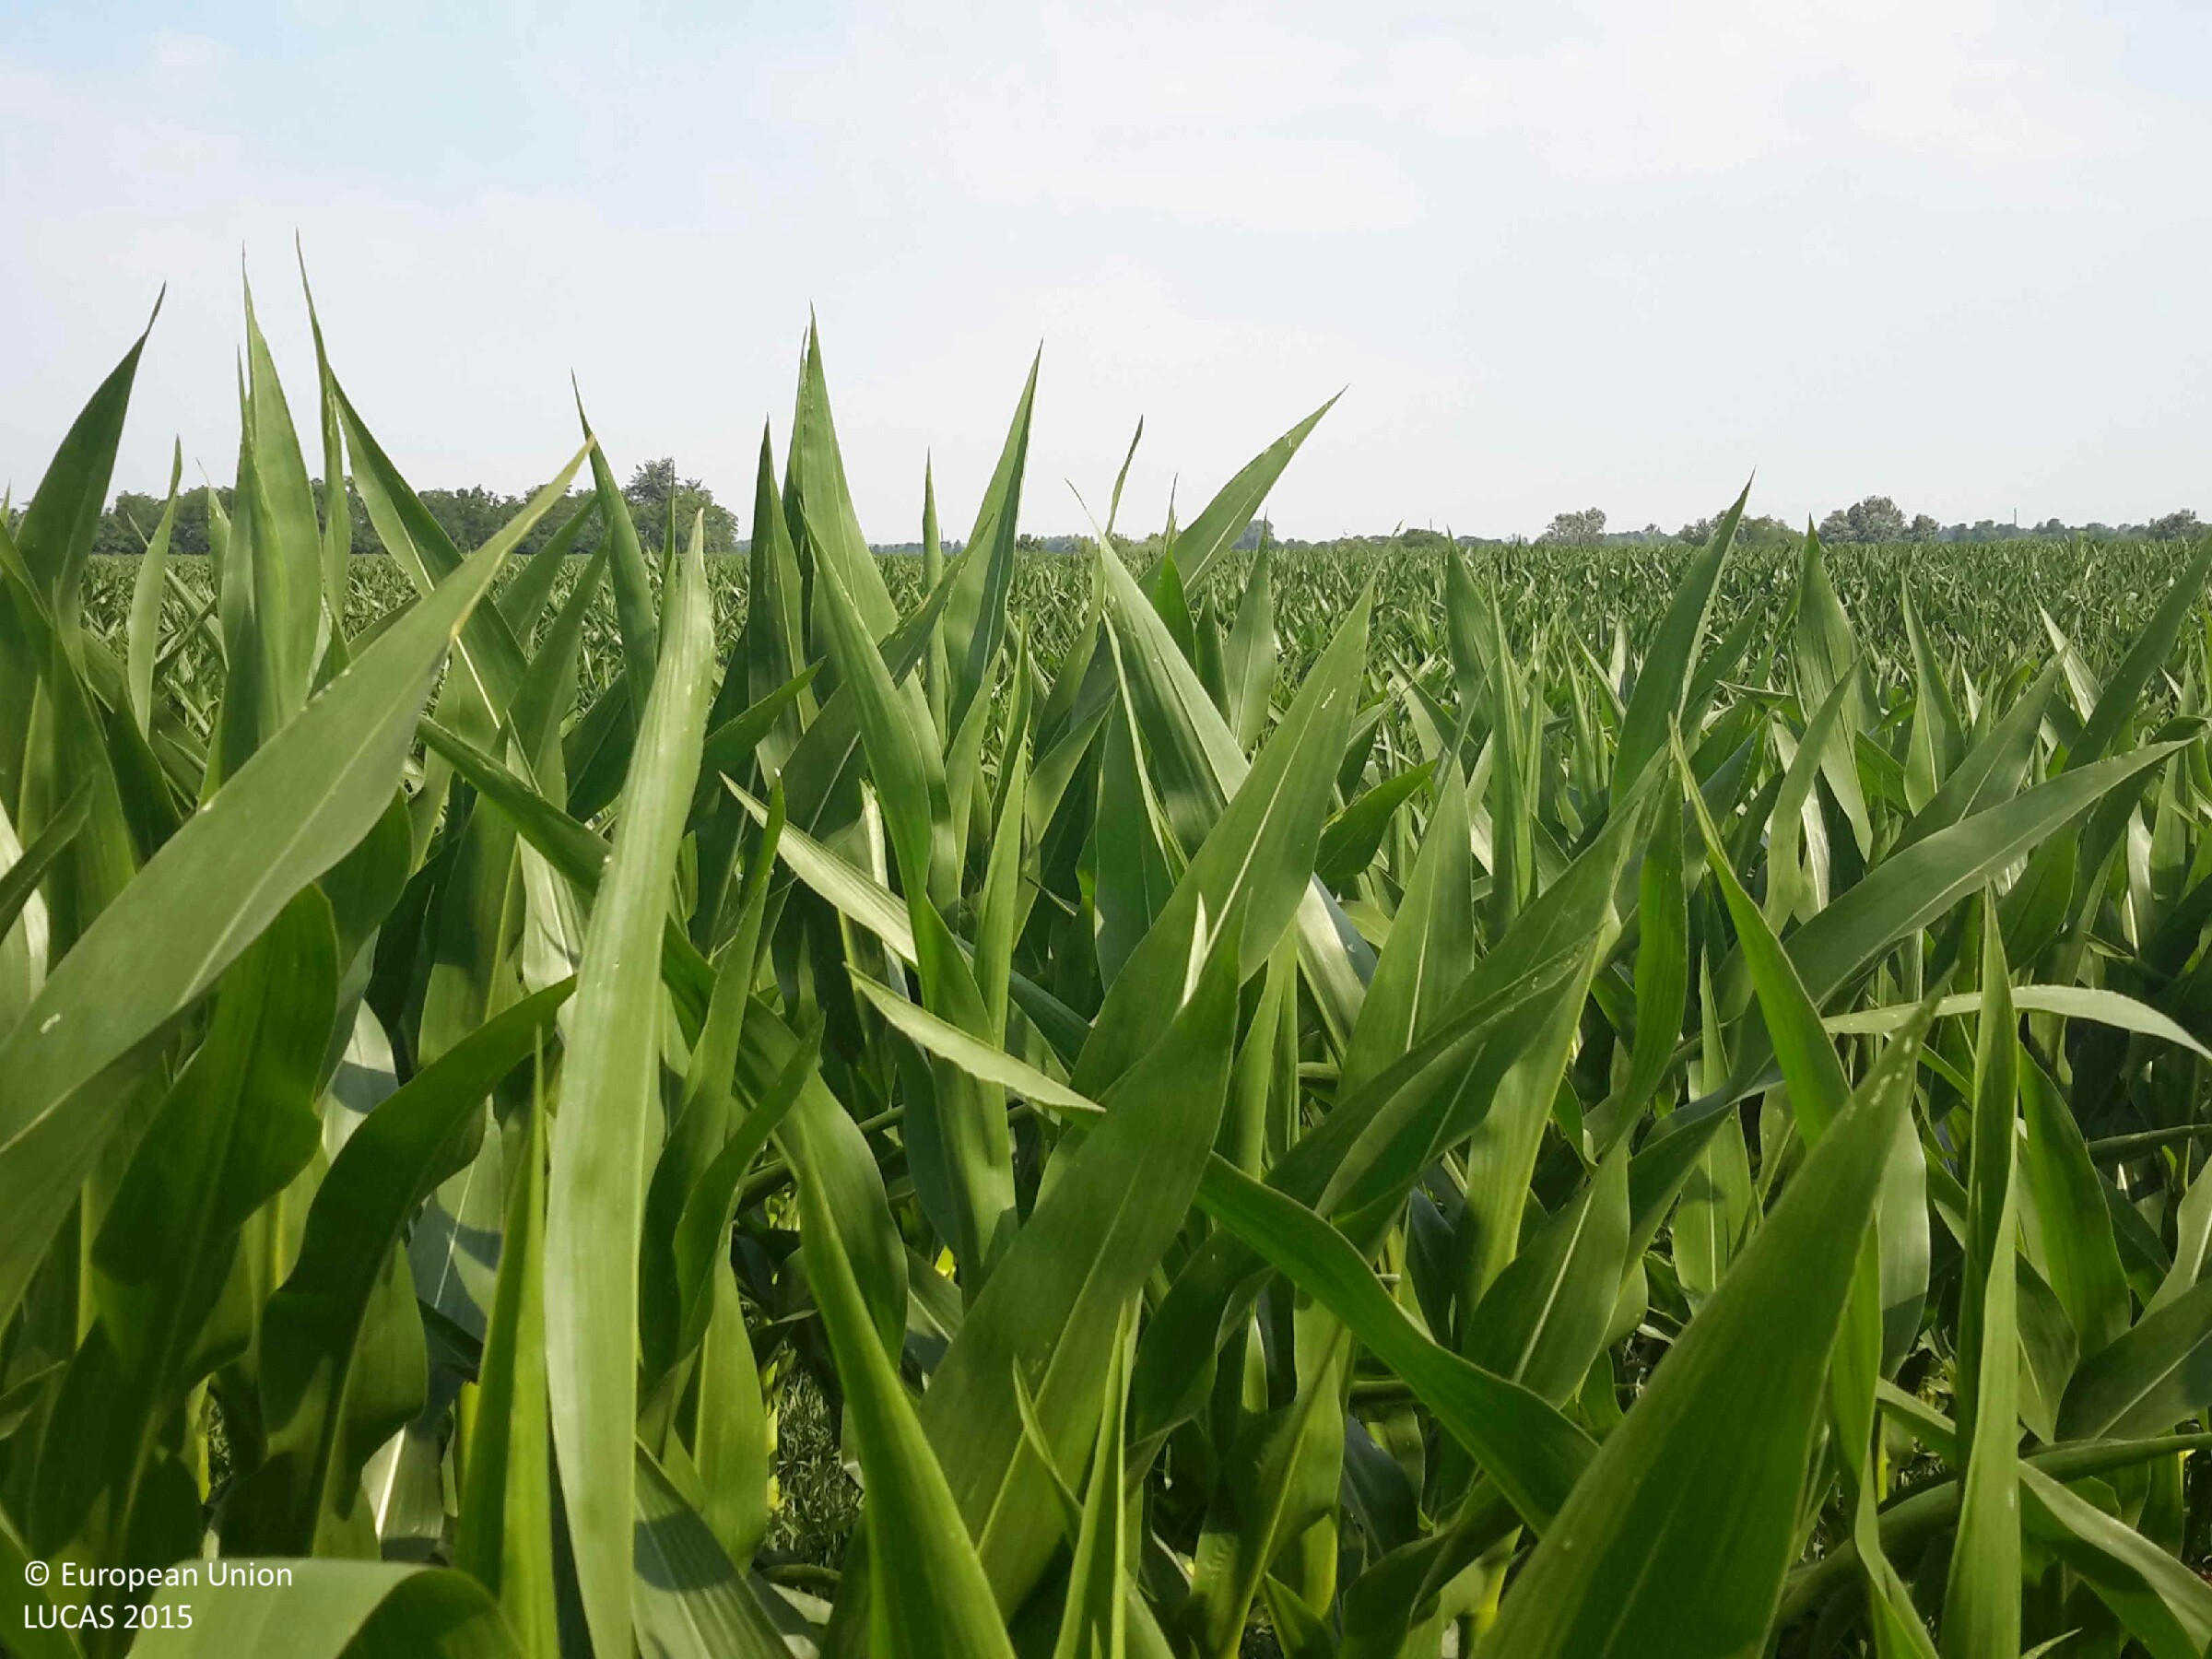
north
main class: Cropland
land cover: Maize
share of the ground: > 75 %
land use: Agriculture (excluding fallow land and kitchen gardens)
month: July
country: HU
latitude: 47.3955
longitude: 17.4135
